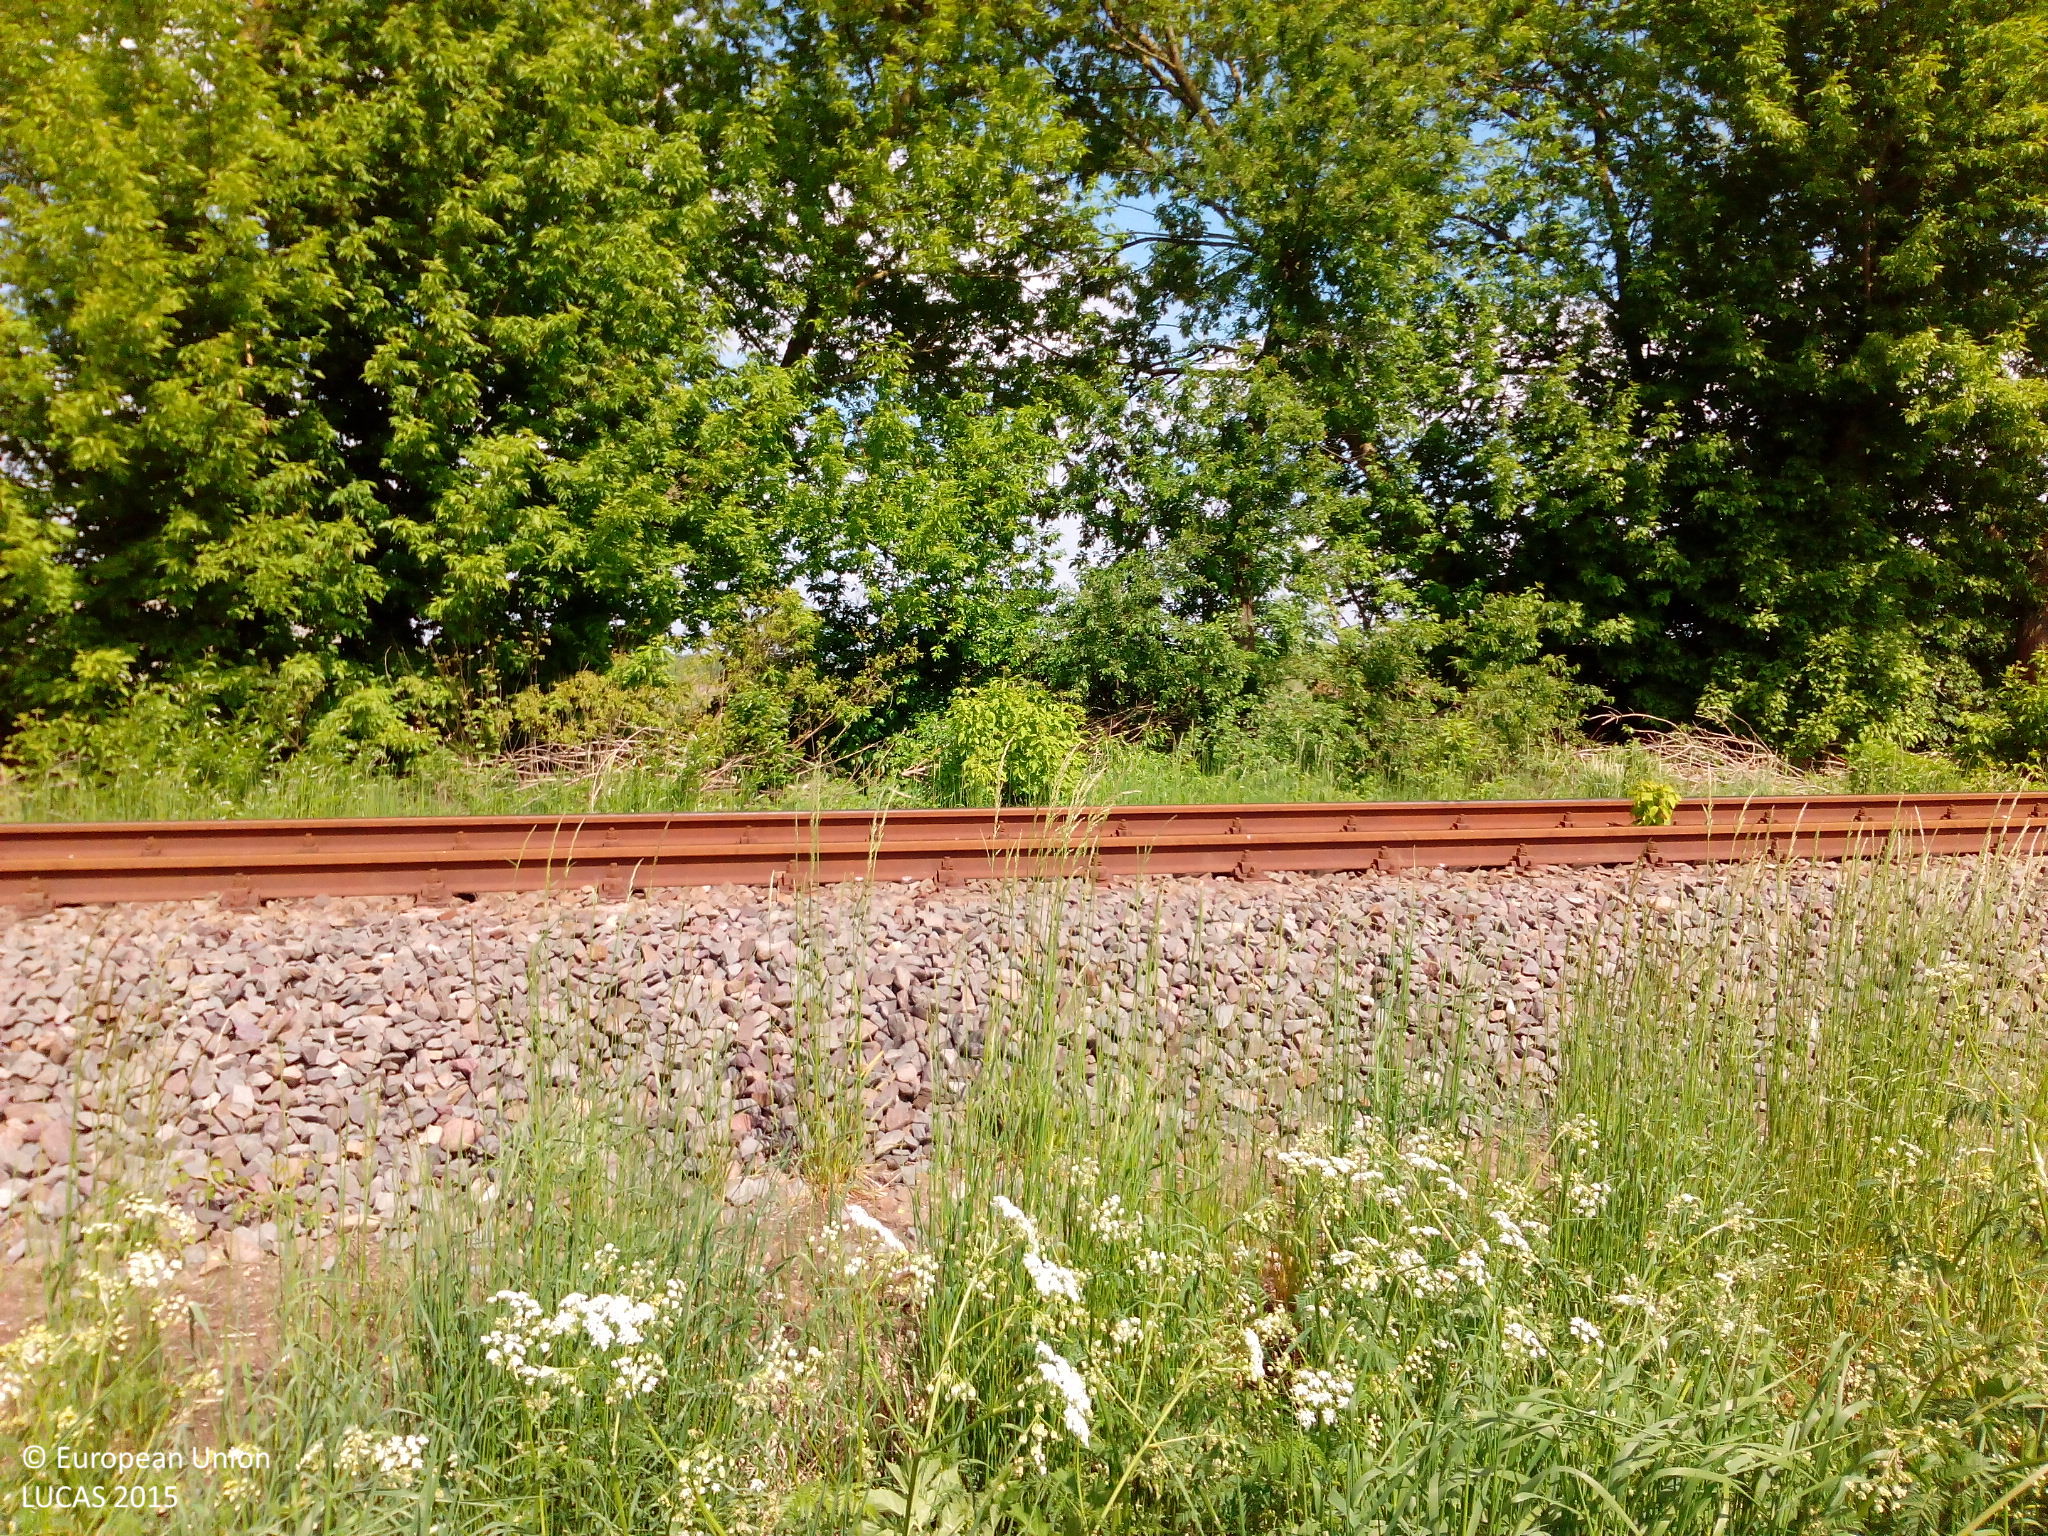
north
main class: Cropland
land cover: Oats
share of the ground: > 75 %
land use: Agriculture (excluding fallow land and kitchen gardens)
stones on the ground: < 10 %
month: May
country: DE
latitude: 53.3909
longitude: 11.6384
